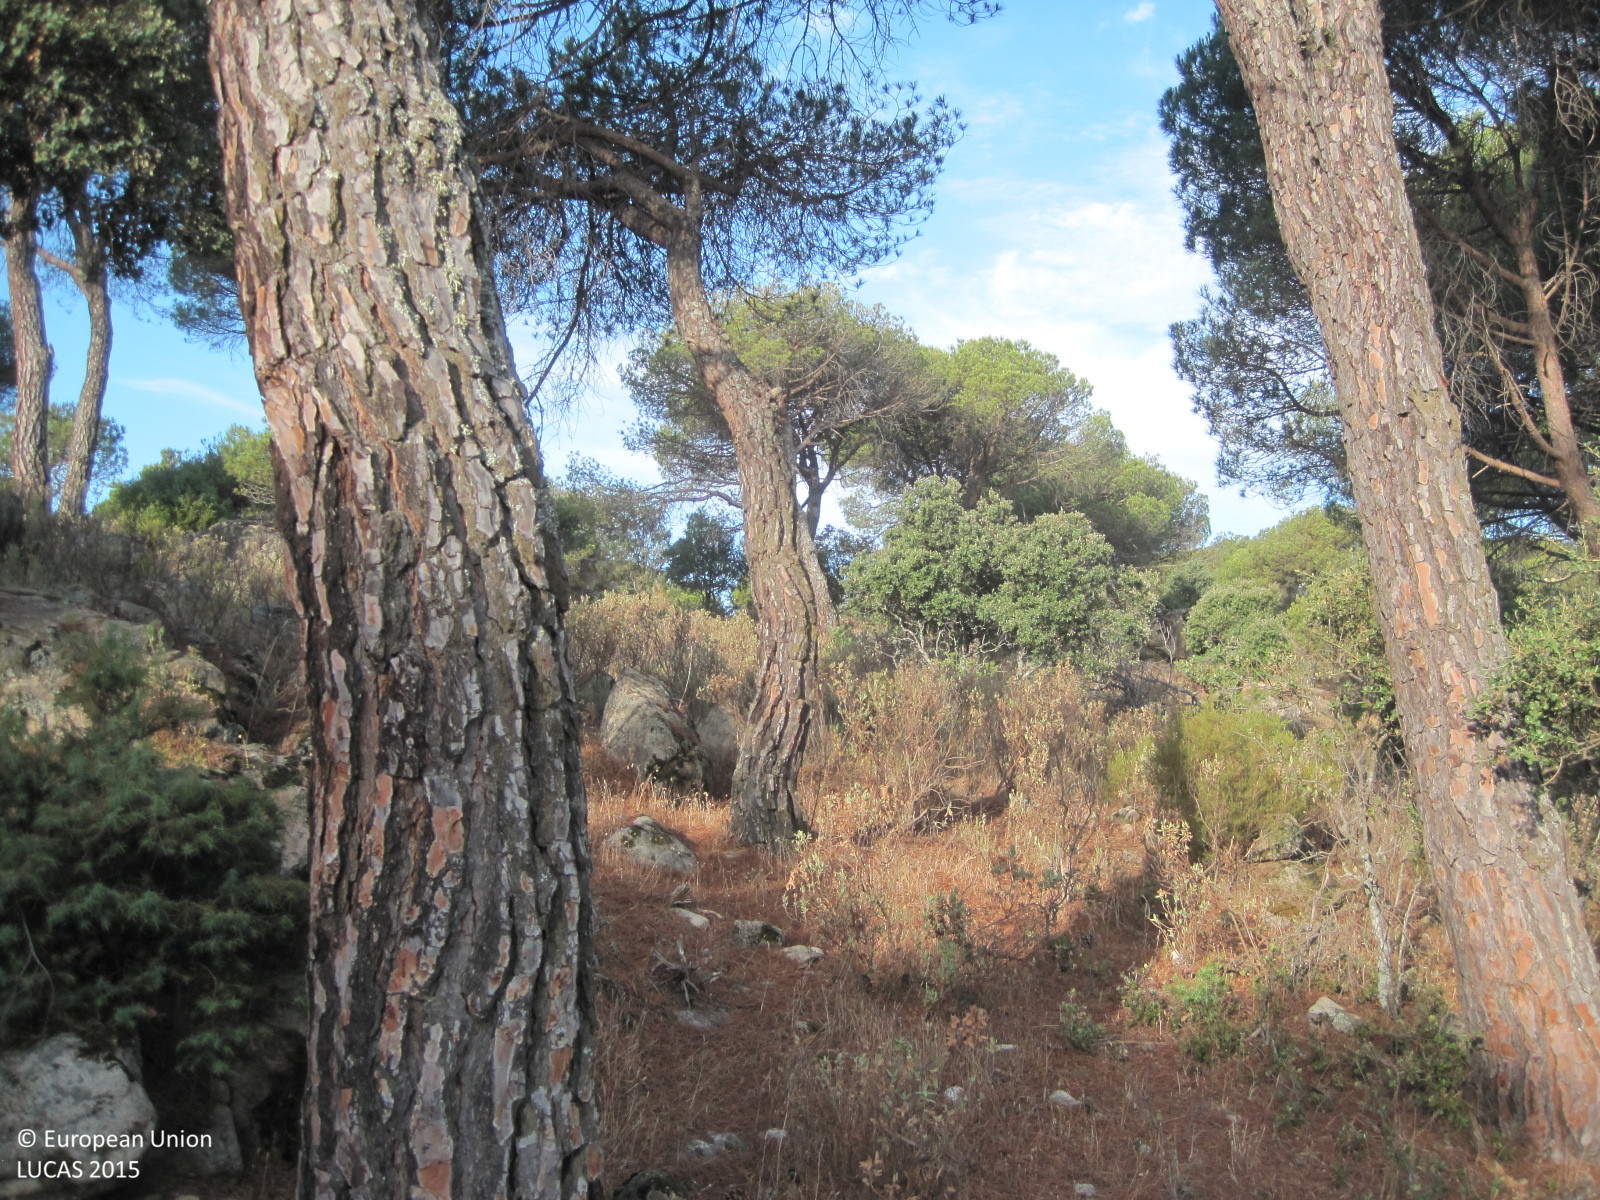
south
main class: Woodland
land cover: Pine dominated mixed woodland
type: coniferous forest of the mediterranean region
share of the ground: > 75 %
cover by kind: coniferous forest trees 50 %, broadleaved forest trees 25 %, shrubs 10 %, herbaceous plants 10 %, unconsolidated bare surface 5 %
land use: Semi-natural and natural areas not in use
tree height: > 5 m
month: July
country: ES
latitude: 40.3401
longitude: -4.3724
